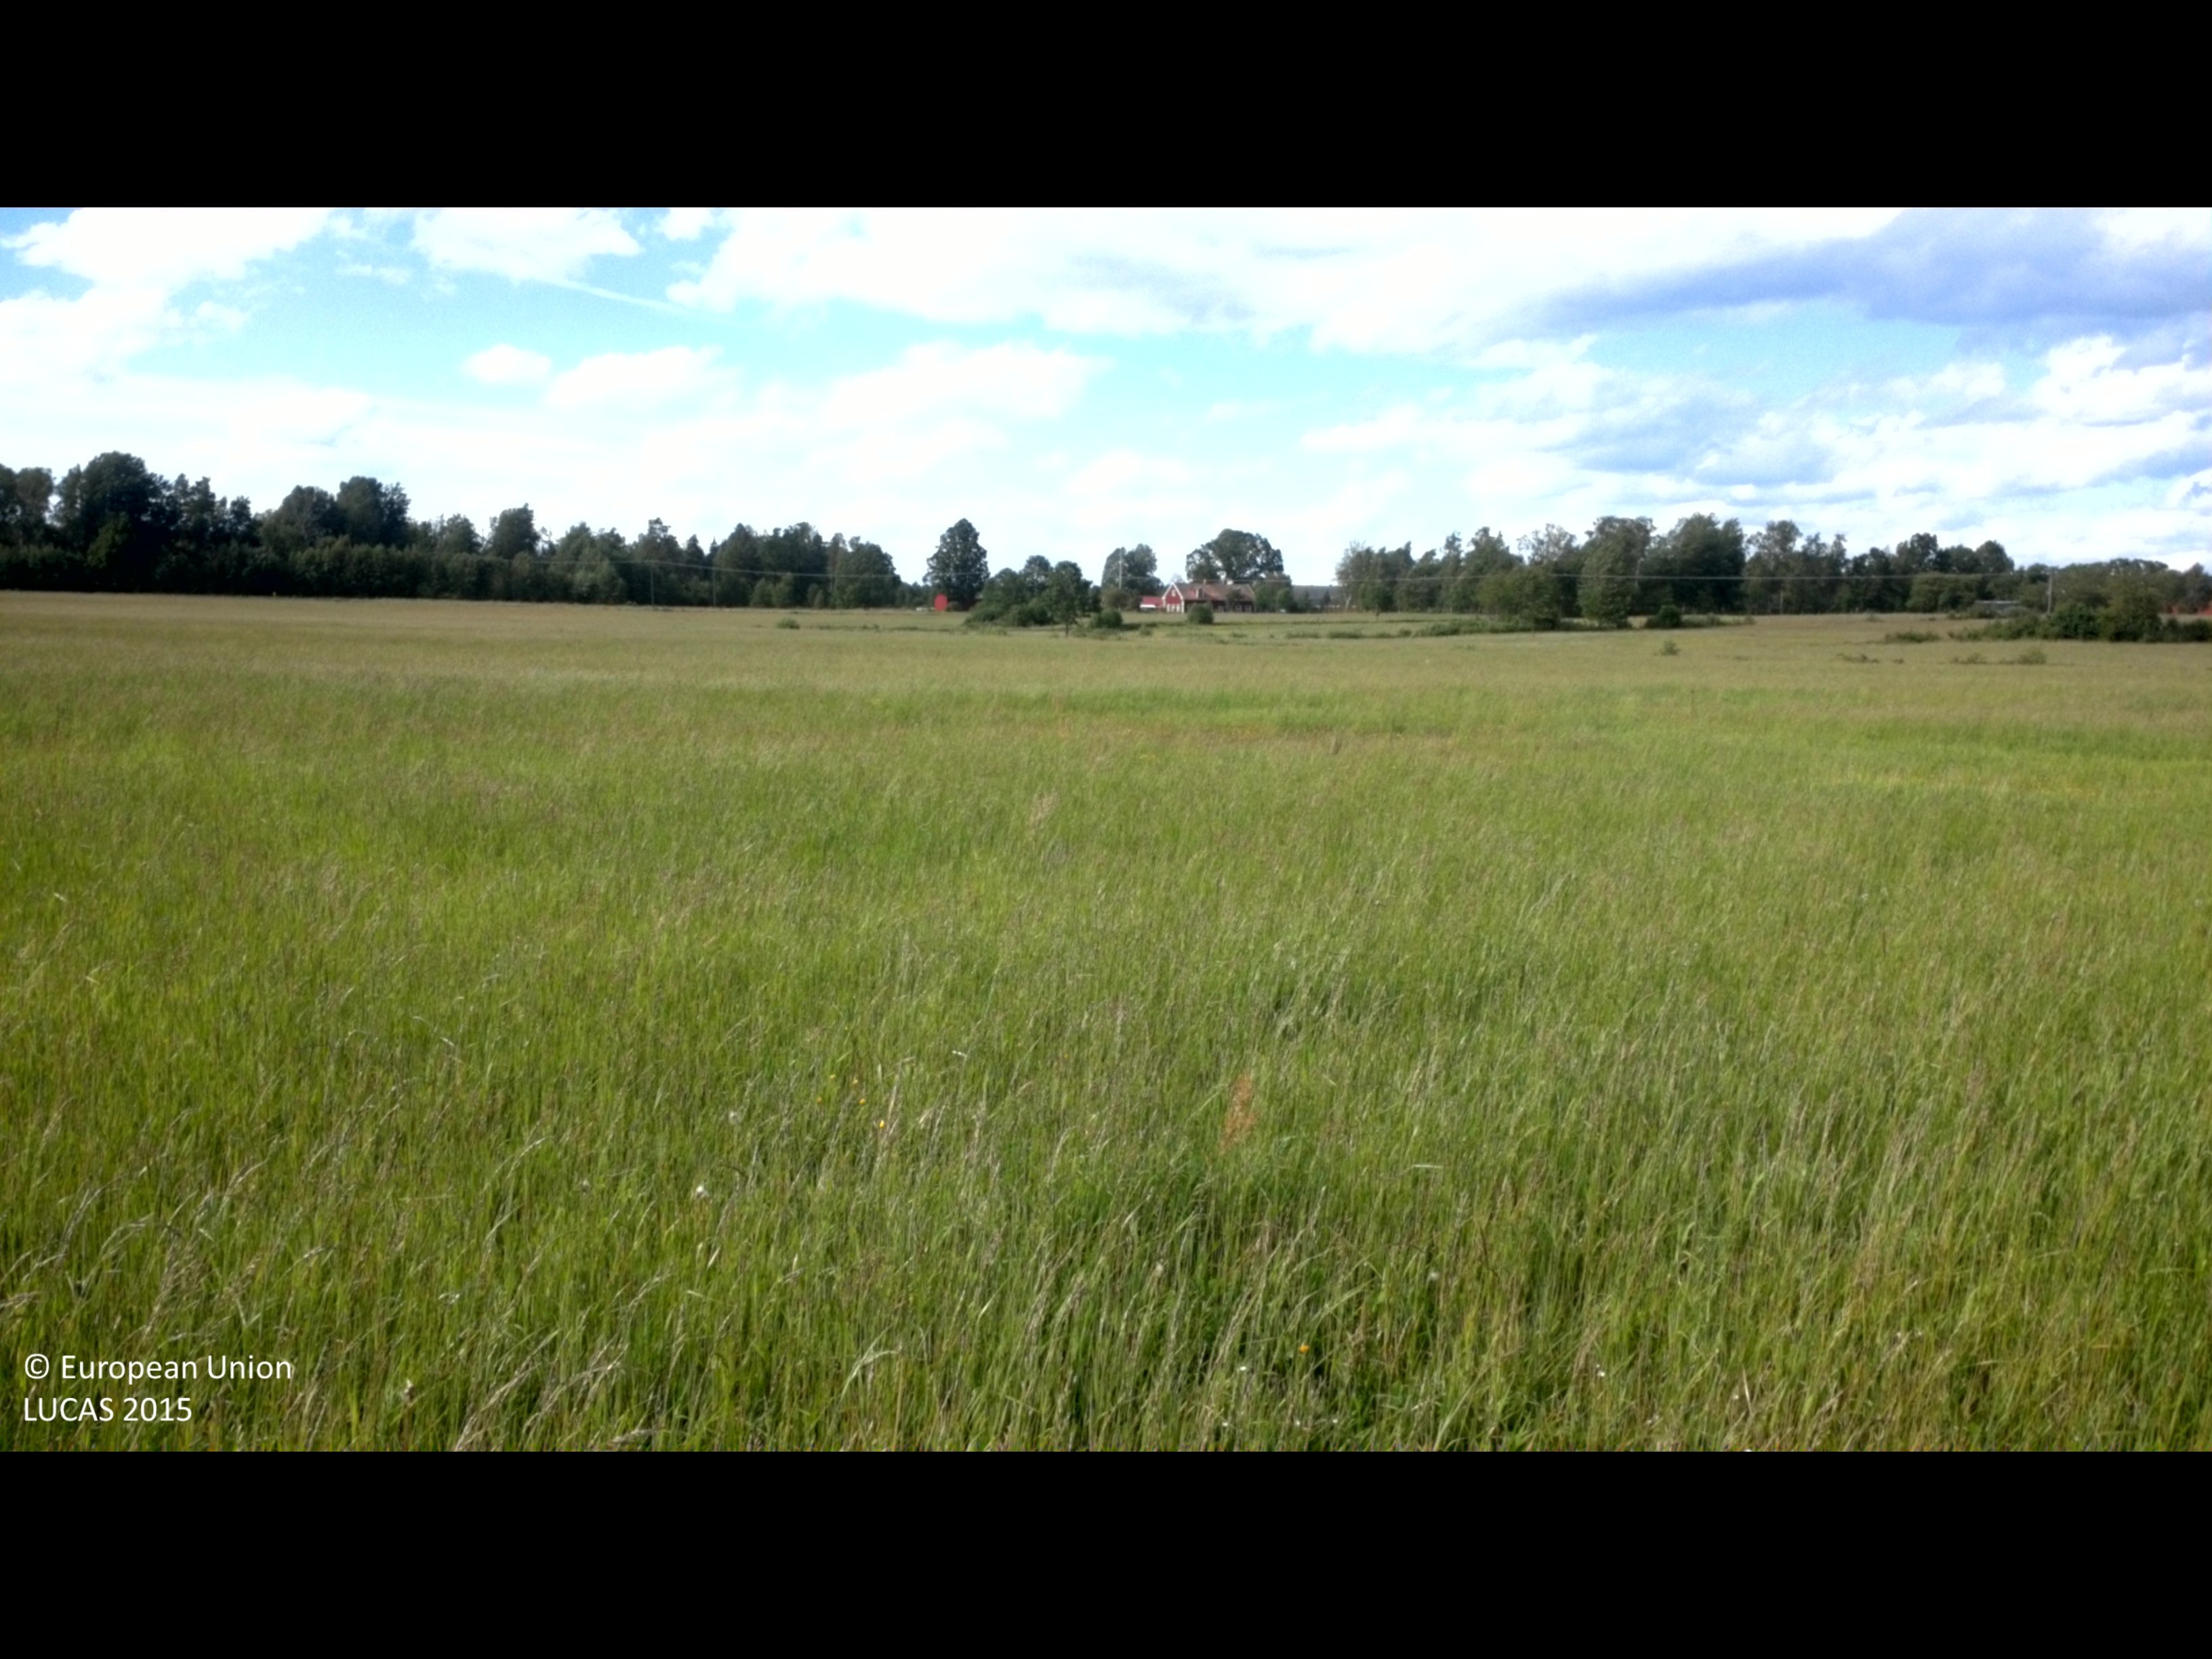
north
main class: Grassland
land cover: Grassland without tree/shrub cover
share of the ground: > 75 %
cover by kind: herbaceous plants 100 %
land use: Agriculture (excluding fallow land and kitchen gardens)
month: June
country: SE
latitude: 57.7715
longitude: 16.5385
